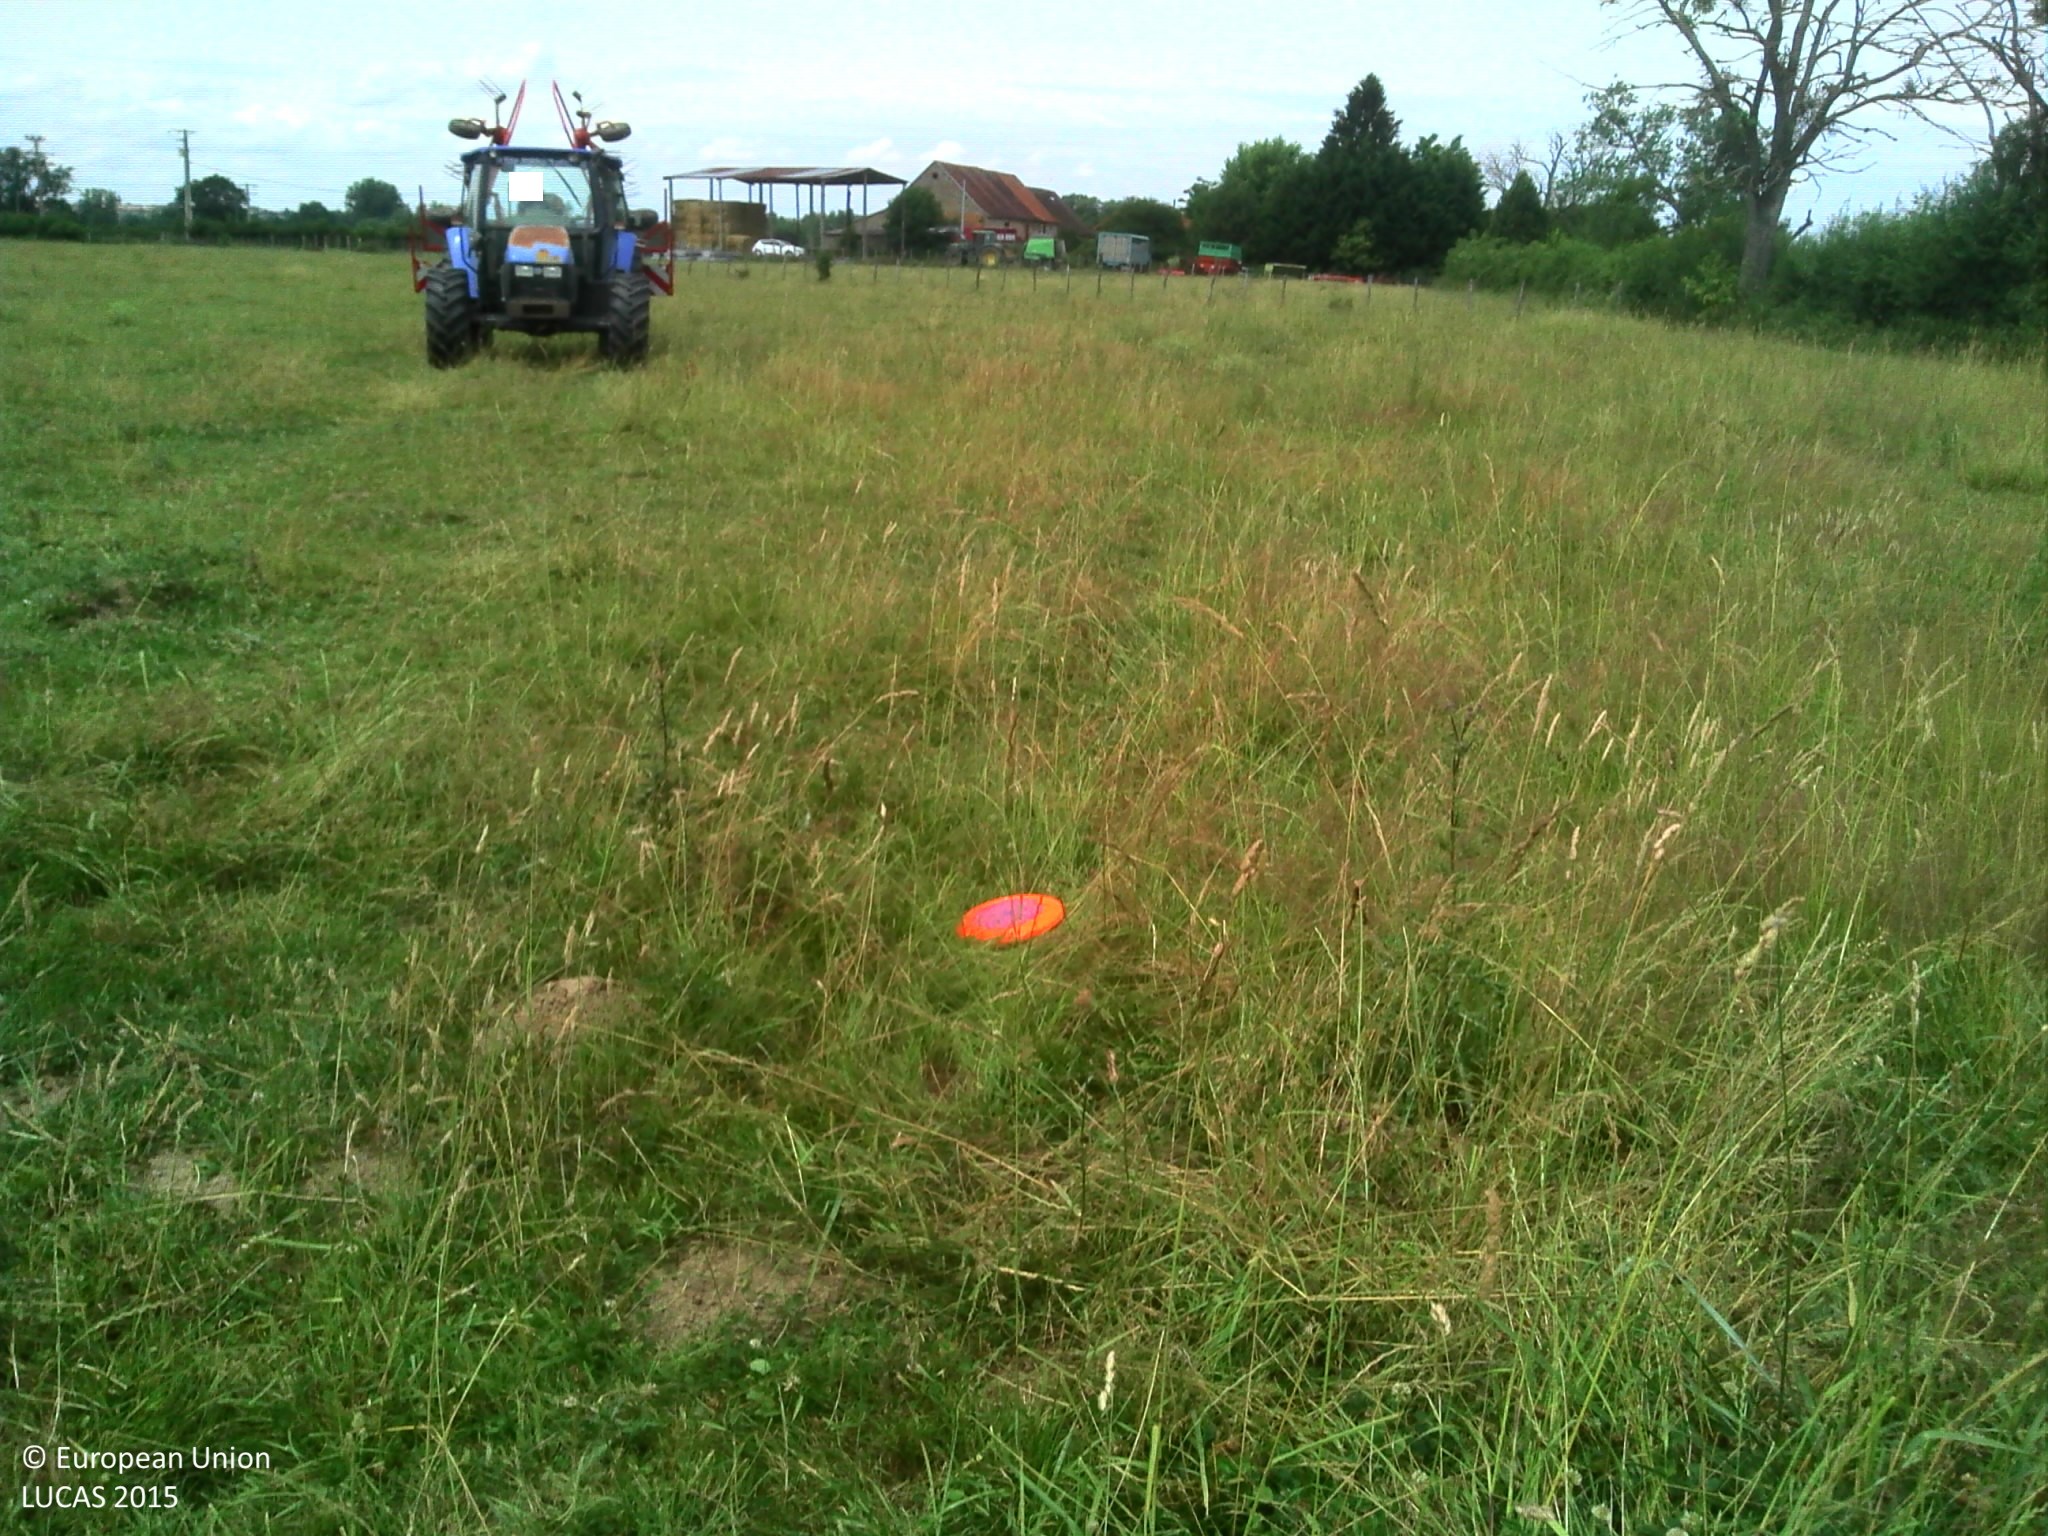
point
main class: Grassland
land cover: Grassland without tree/shrub cover
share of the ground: > 75 %
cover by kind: herbaceous plants 100 %
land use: Agriculture (excluding fallow land and kitchen gardens)
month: June
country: FR
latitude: 46.3100
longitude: 4.0146
